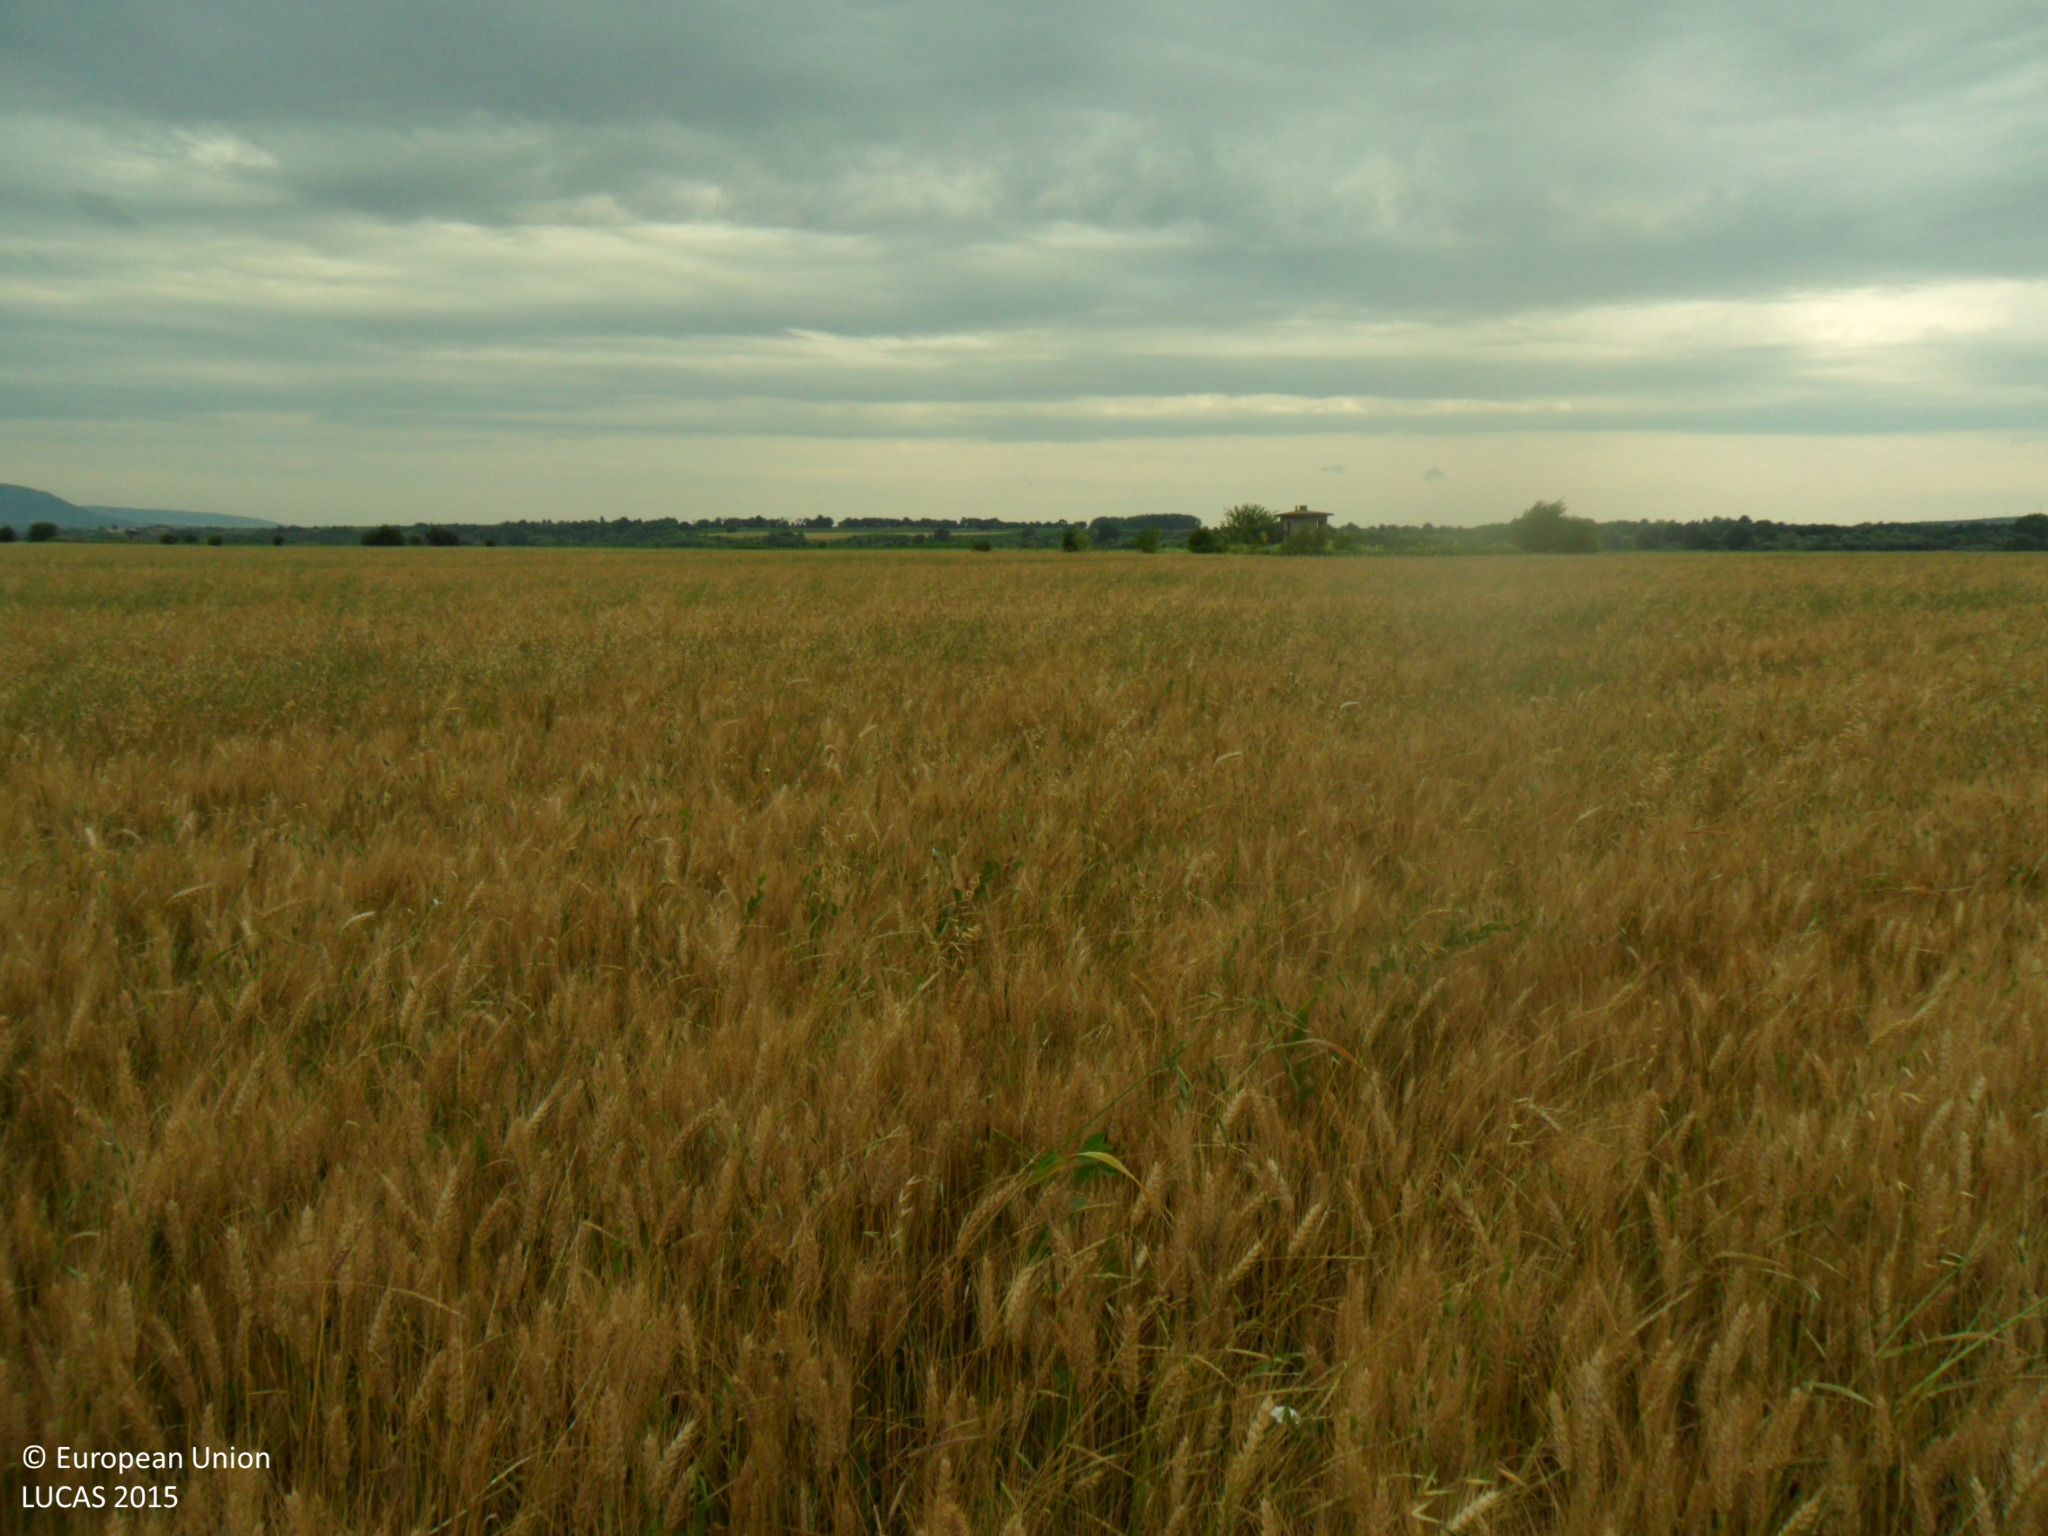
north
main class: Cropland
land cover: Common wheat
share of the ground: > 75 %
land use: Agriculture (excluding fallow land and kitchen gardens)
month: June
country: BG
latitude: 43.1564
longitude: 26.9982
